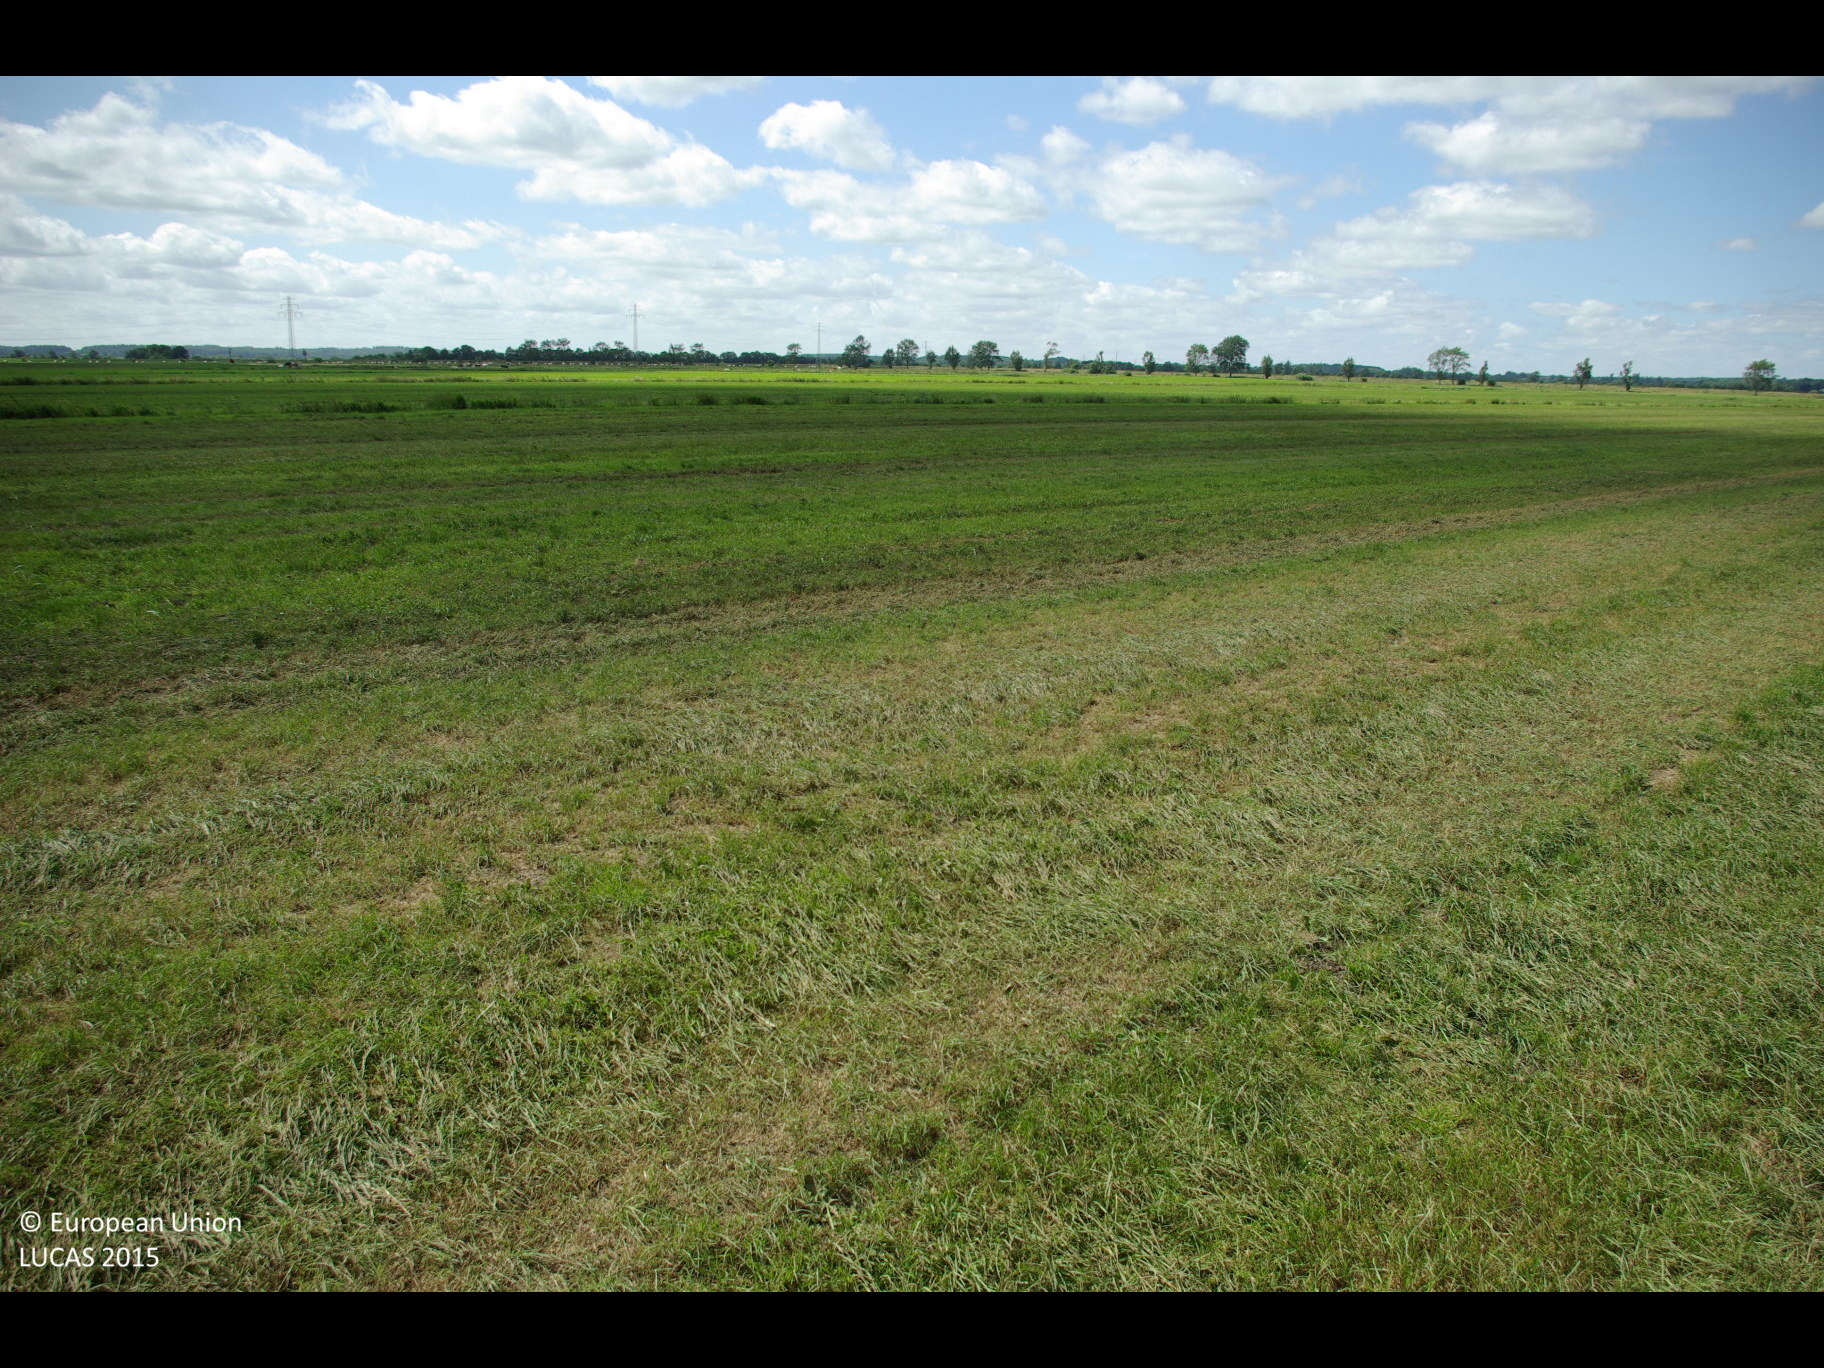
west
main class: Grassland
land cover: Spontaneously vegetated surfaces
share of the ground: > 75 %
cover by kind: herbaceous plants 100 %
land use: Semi-natural and natural areas not in use
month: July
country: DE
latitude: 54.4244
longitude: 9.3069
